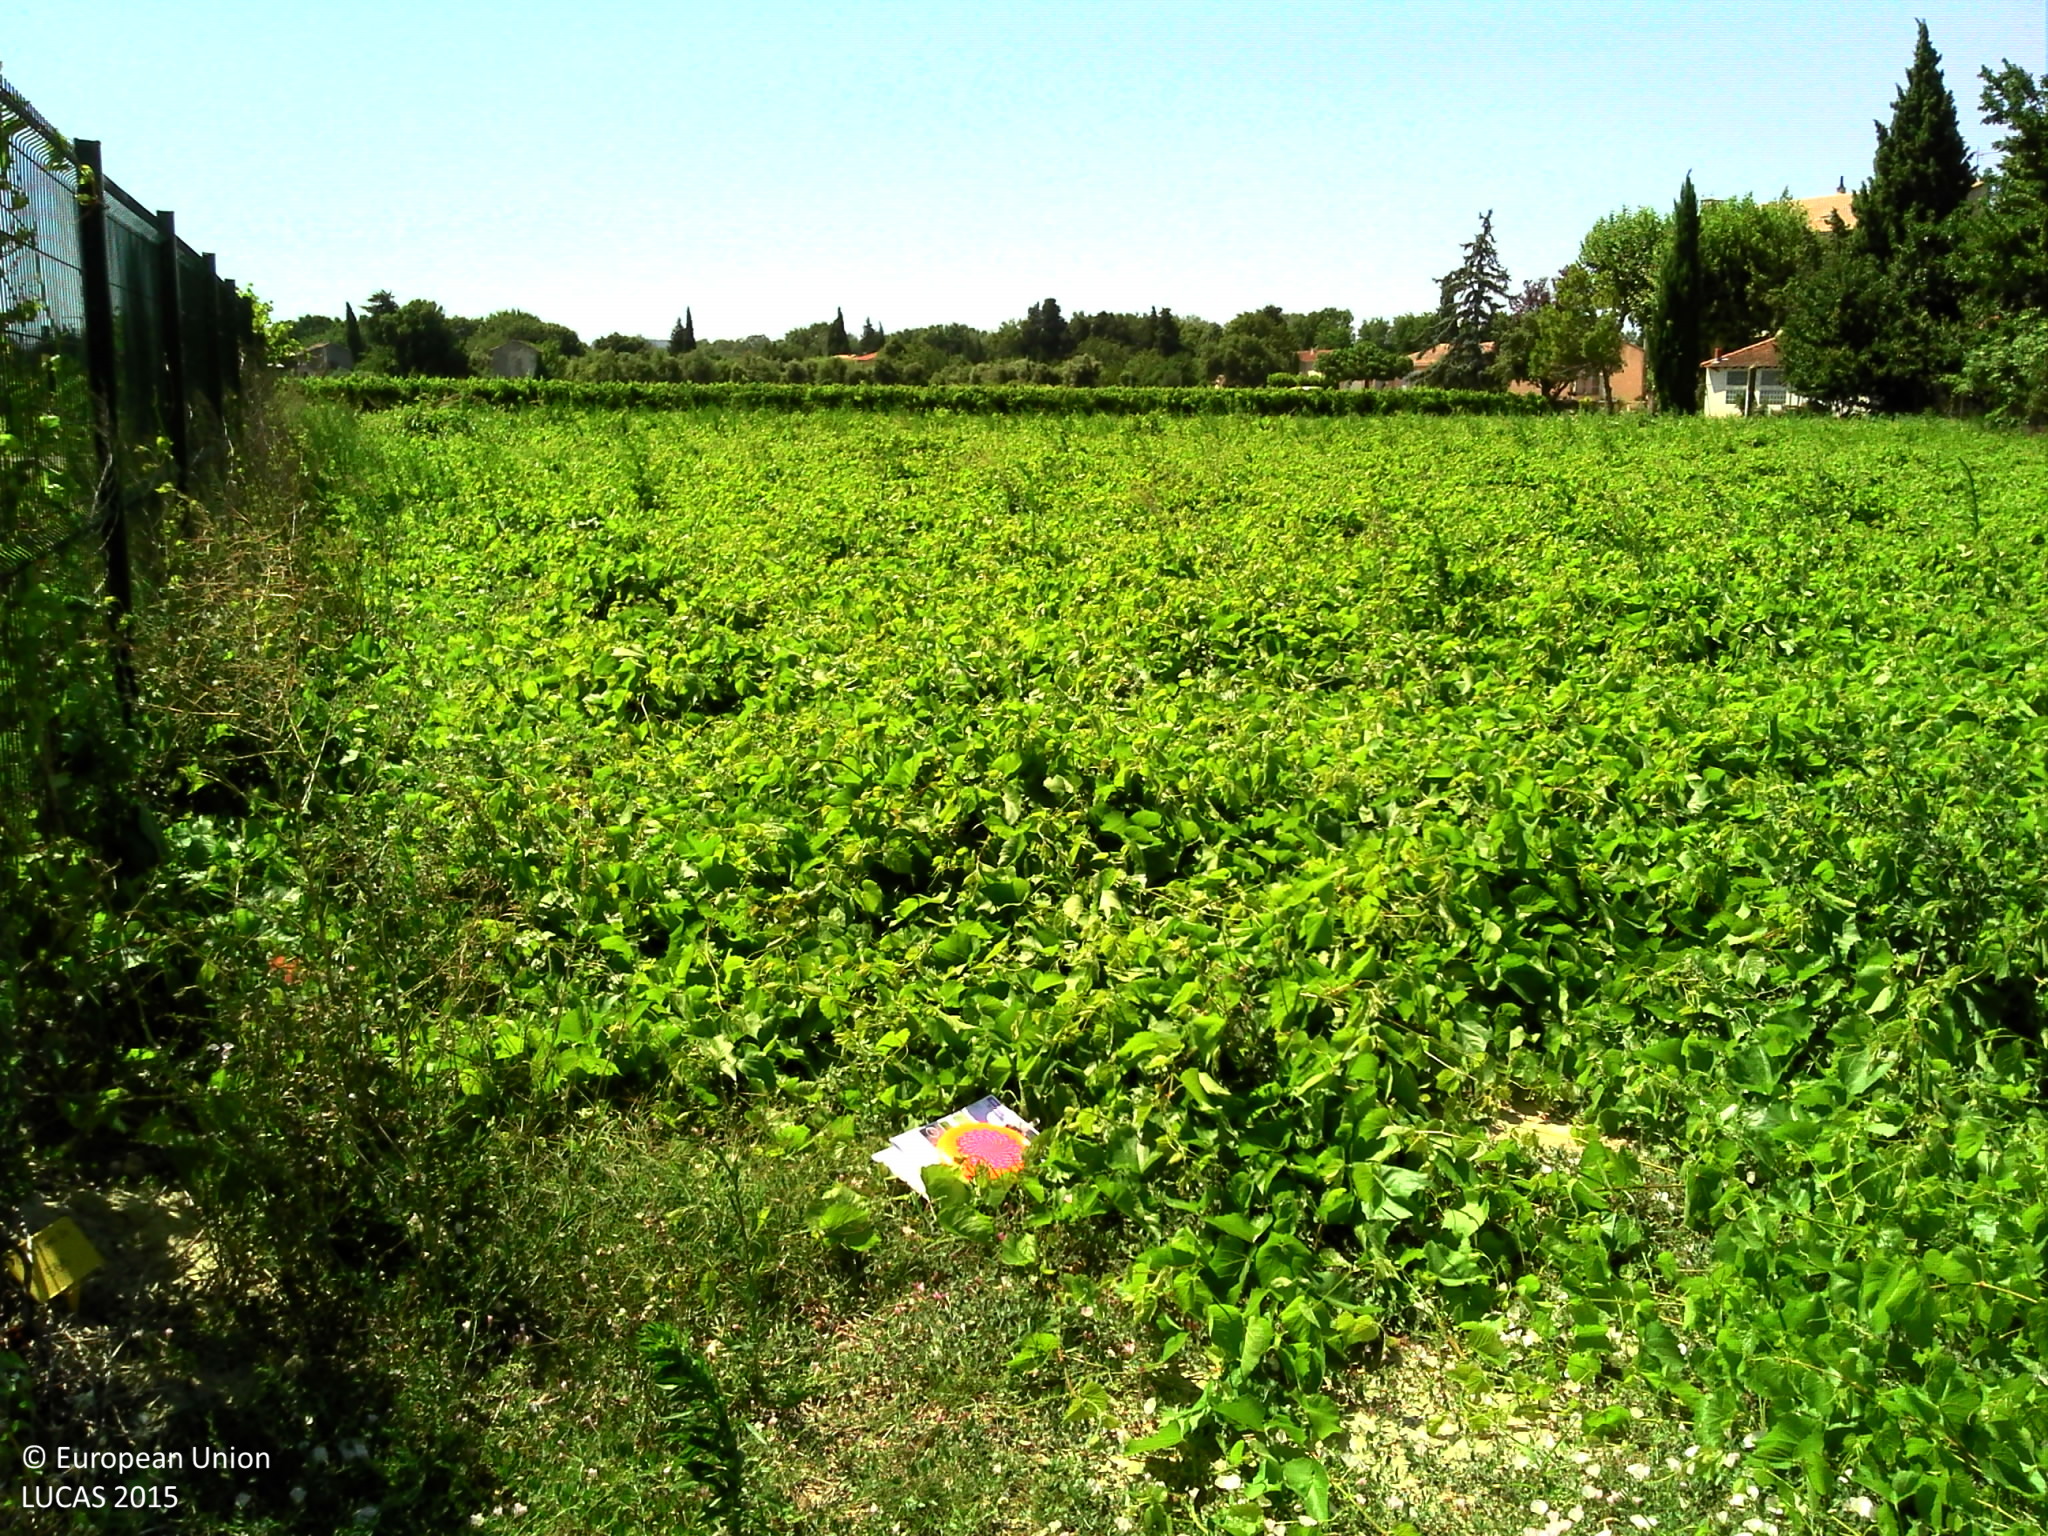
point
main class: Cropland
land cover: Nurseries
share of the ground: > 75 %
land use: Agriculture (excluding fallow land and kitchen gardens)
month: July
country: FR
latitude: 44.1476
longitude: 4.7946
